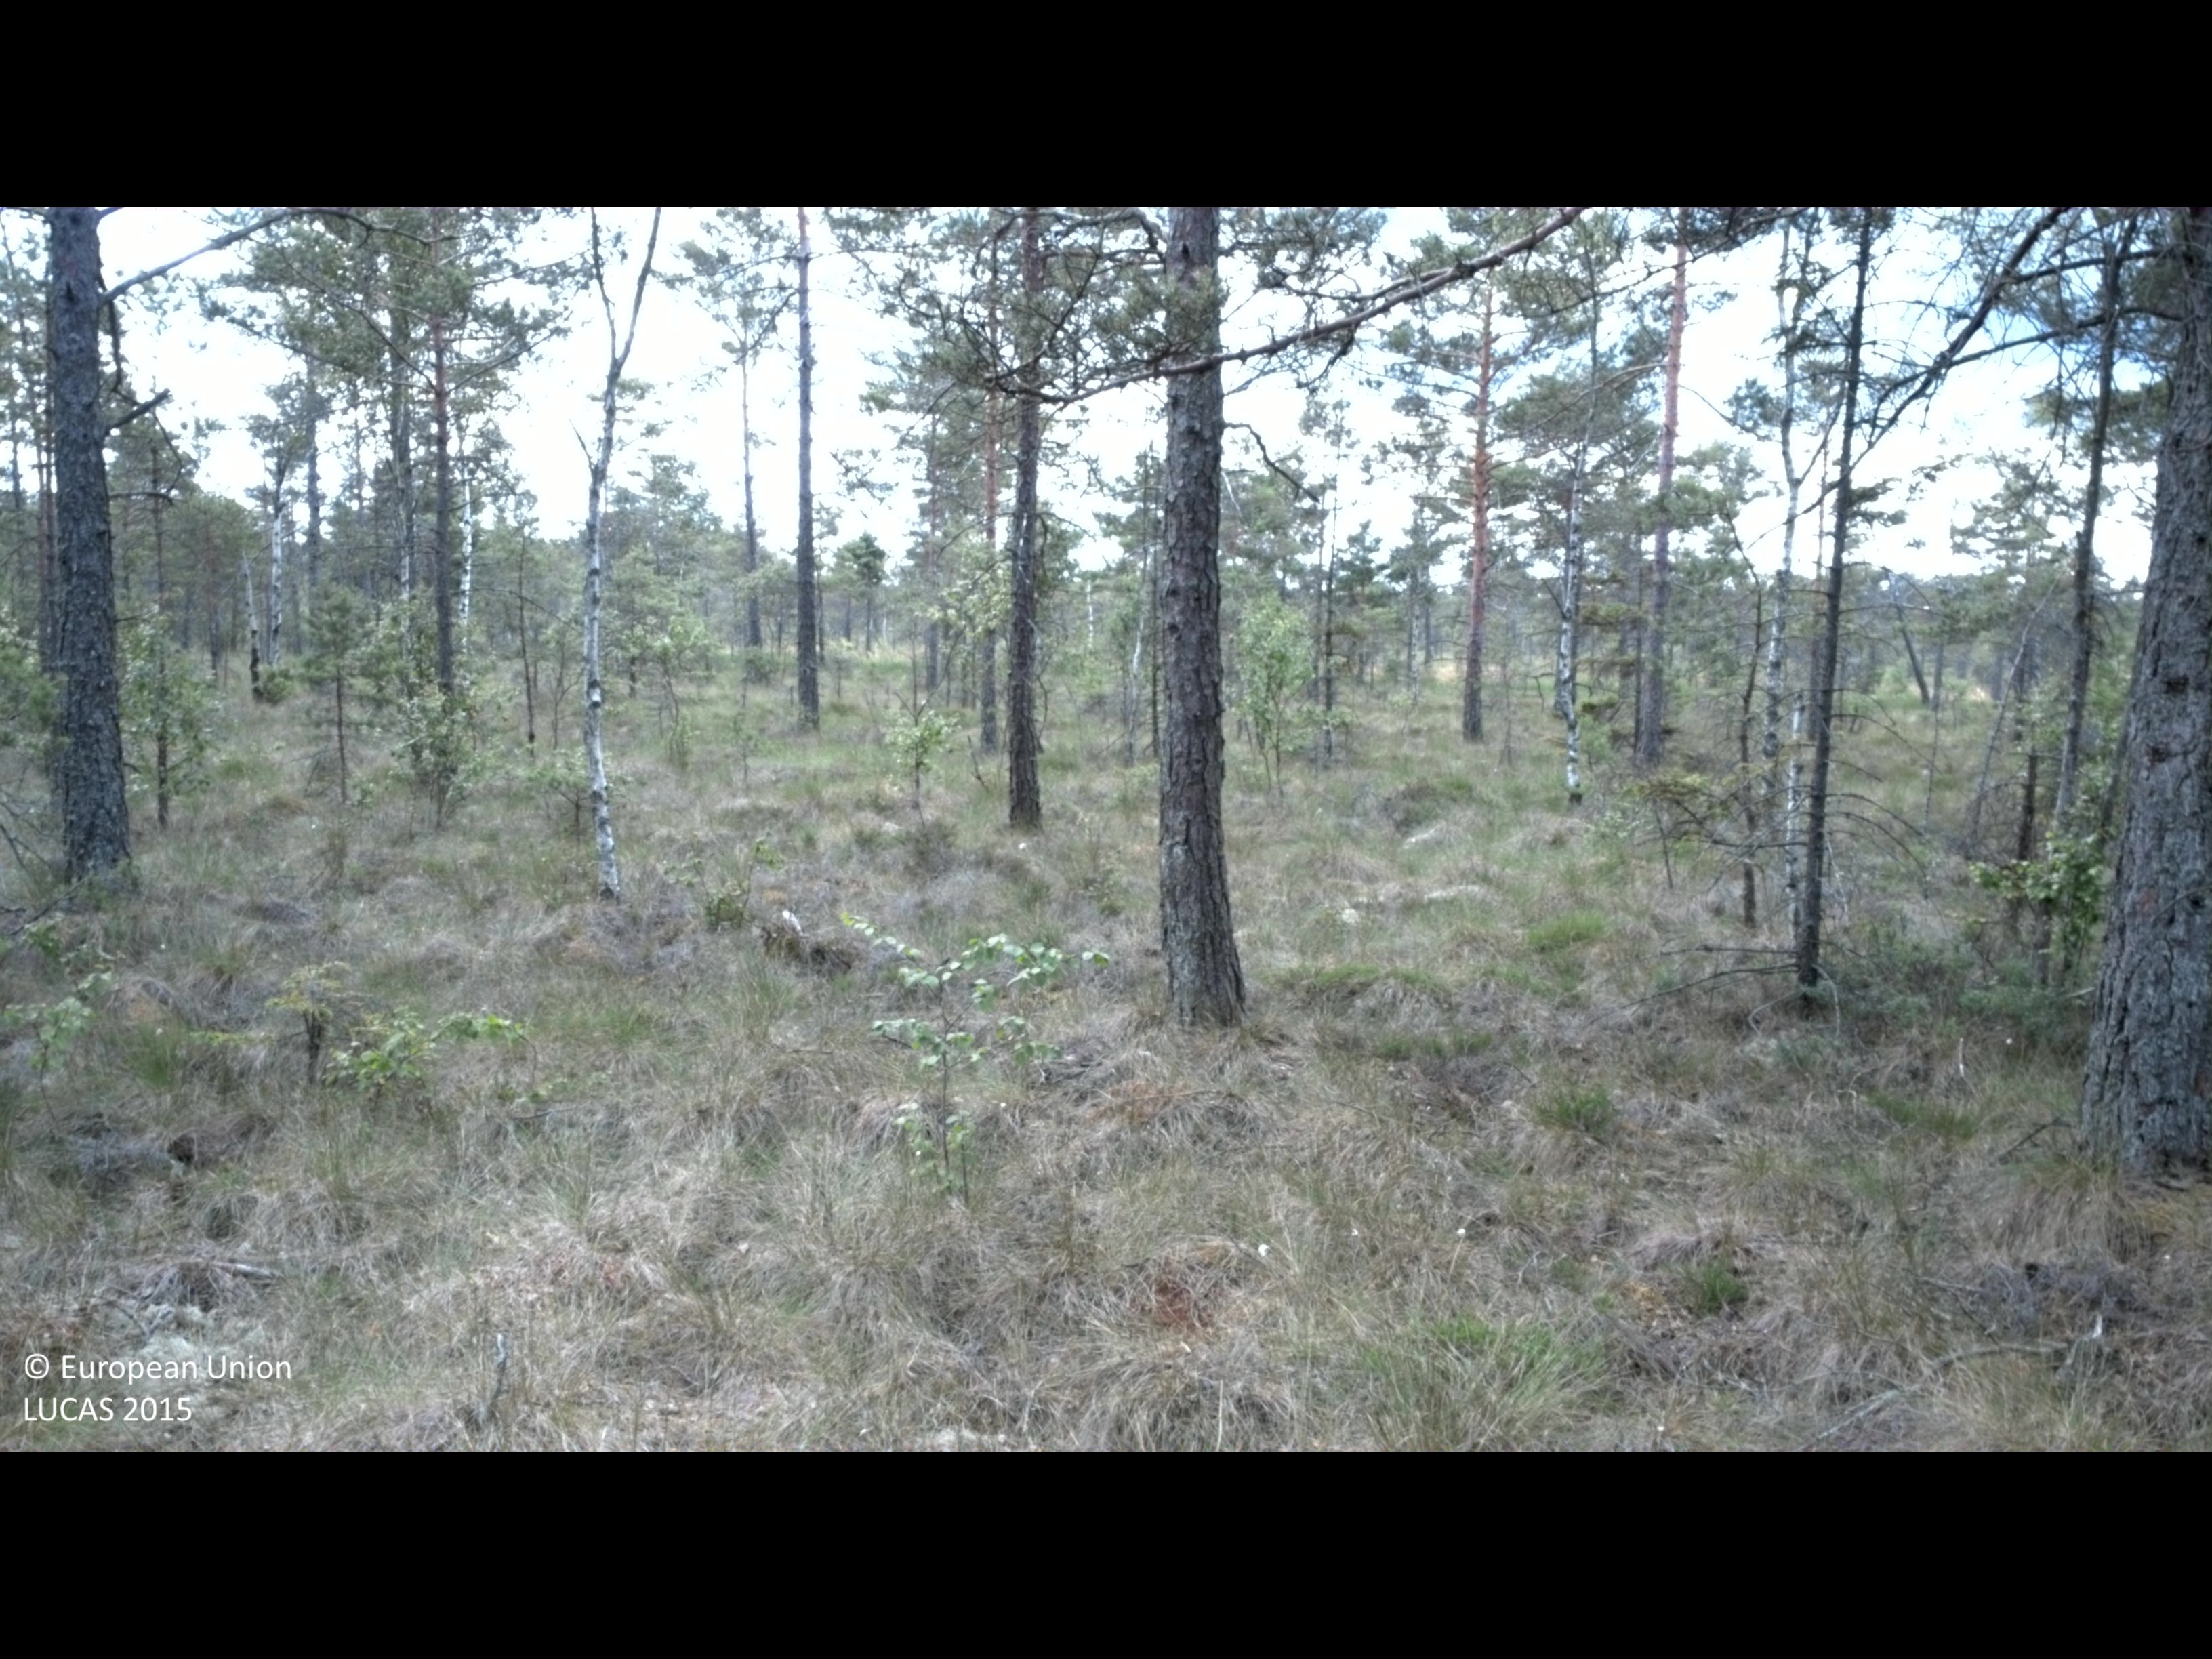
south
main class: Woodland
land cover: Pine dominated mixed woodland
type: mire and swamp forests
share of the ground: 50 - 75 %
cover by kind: coniferous forest trees 40 %, broadleaved forest trees 20 %, herbaceous plants 20 %, shrubs 10 %, lichens and mosses 10 %
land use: Semi-natural and natural areas not in use
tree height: > 5 m
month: July
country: SE
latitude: 56.5667
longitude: 14.2772
